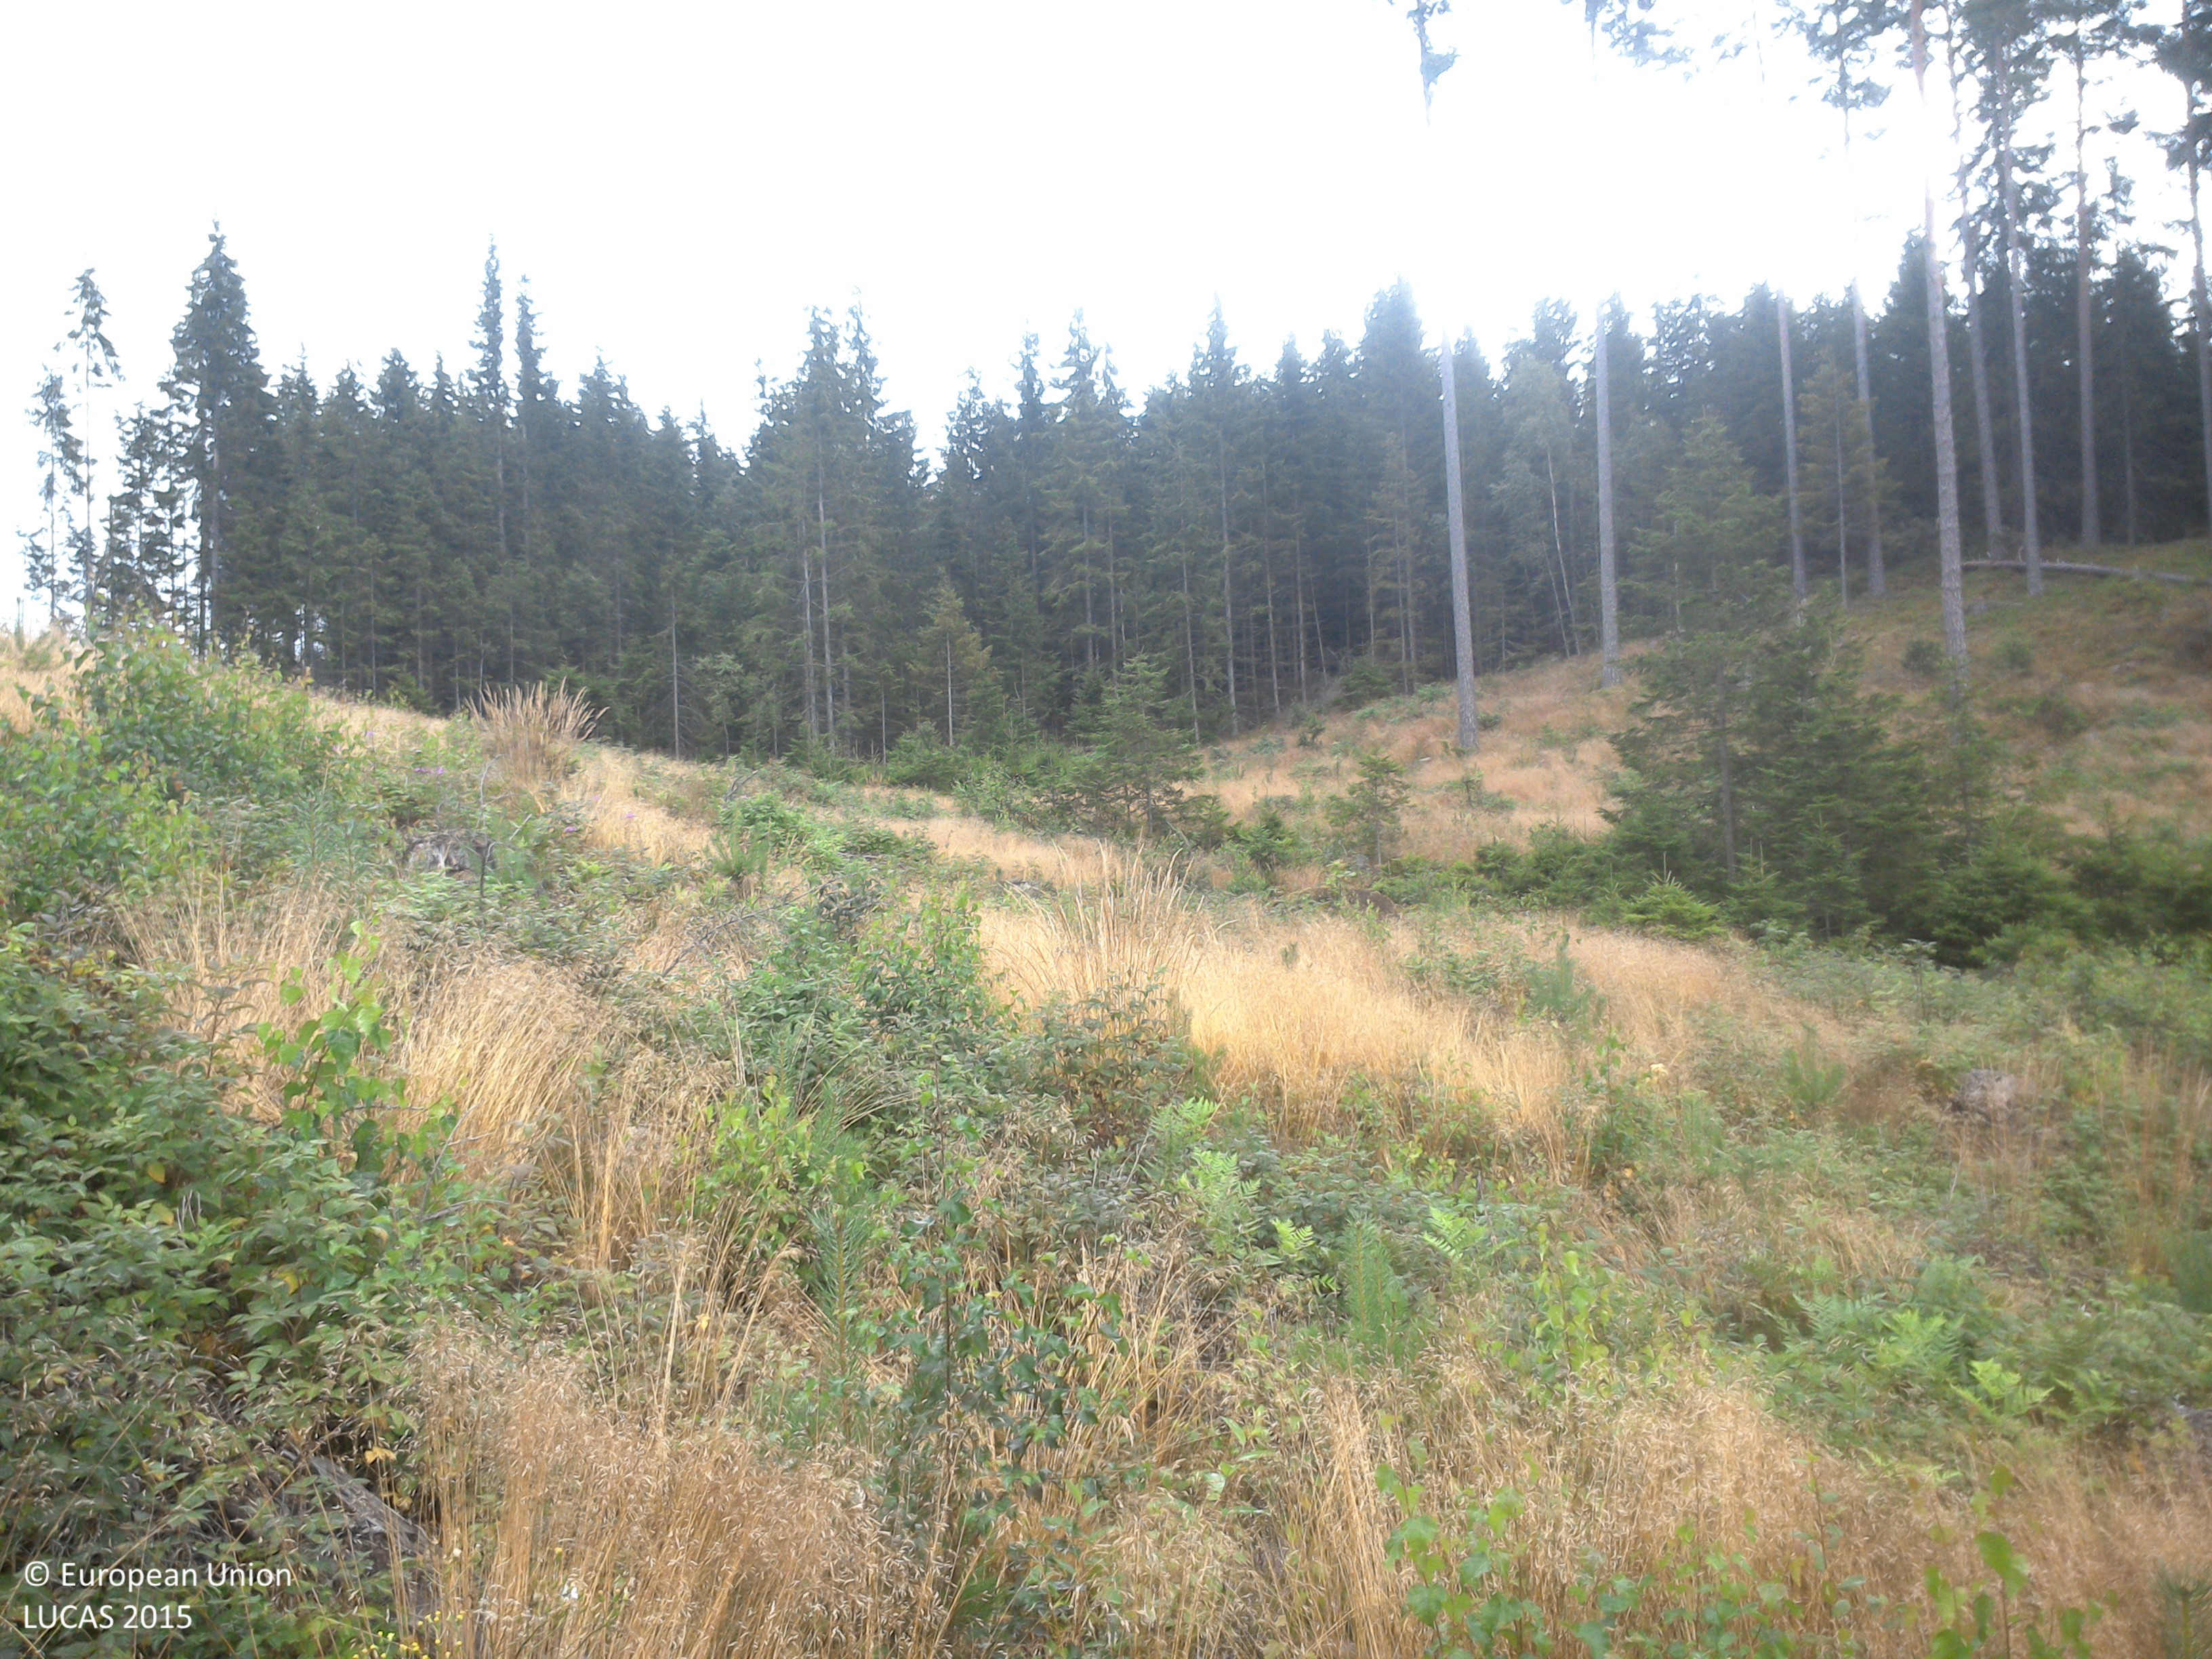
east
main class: Shrubland
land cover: Shrubland with sparse tree cover
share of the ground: 50 - 75 %
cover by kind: shrubs 60 %, herbaceous plants 35 %, coniferous forest trees 5 %
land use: Forestry
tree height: < 5 m
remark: Clear cut
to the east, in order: Shrubland with sparse tree cover; Tracks; Shrubland with sparse tree cover; Spruce dominated coniferous woodland; Pine dominated coniferous woodland; Spruce dominated coniferous woodland
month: August
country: SE
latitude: 57.7191
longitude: 15.2841
